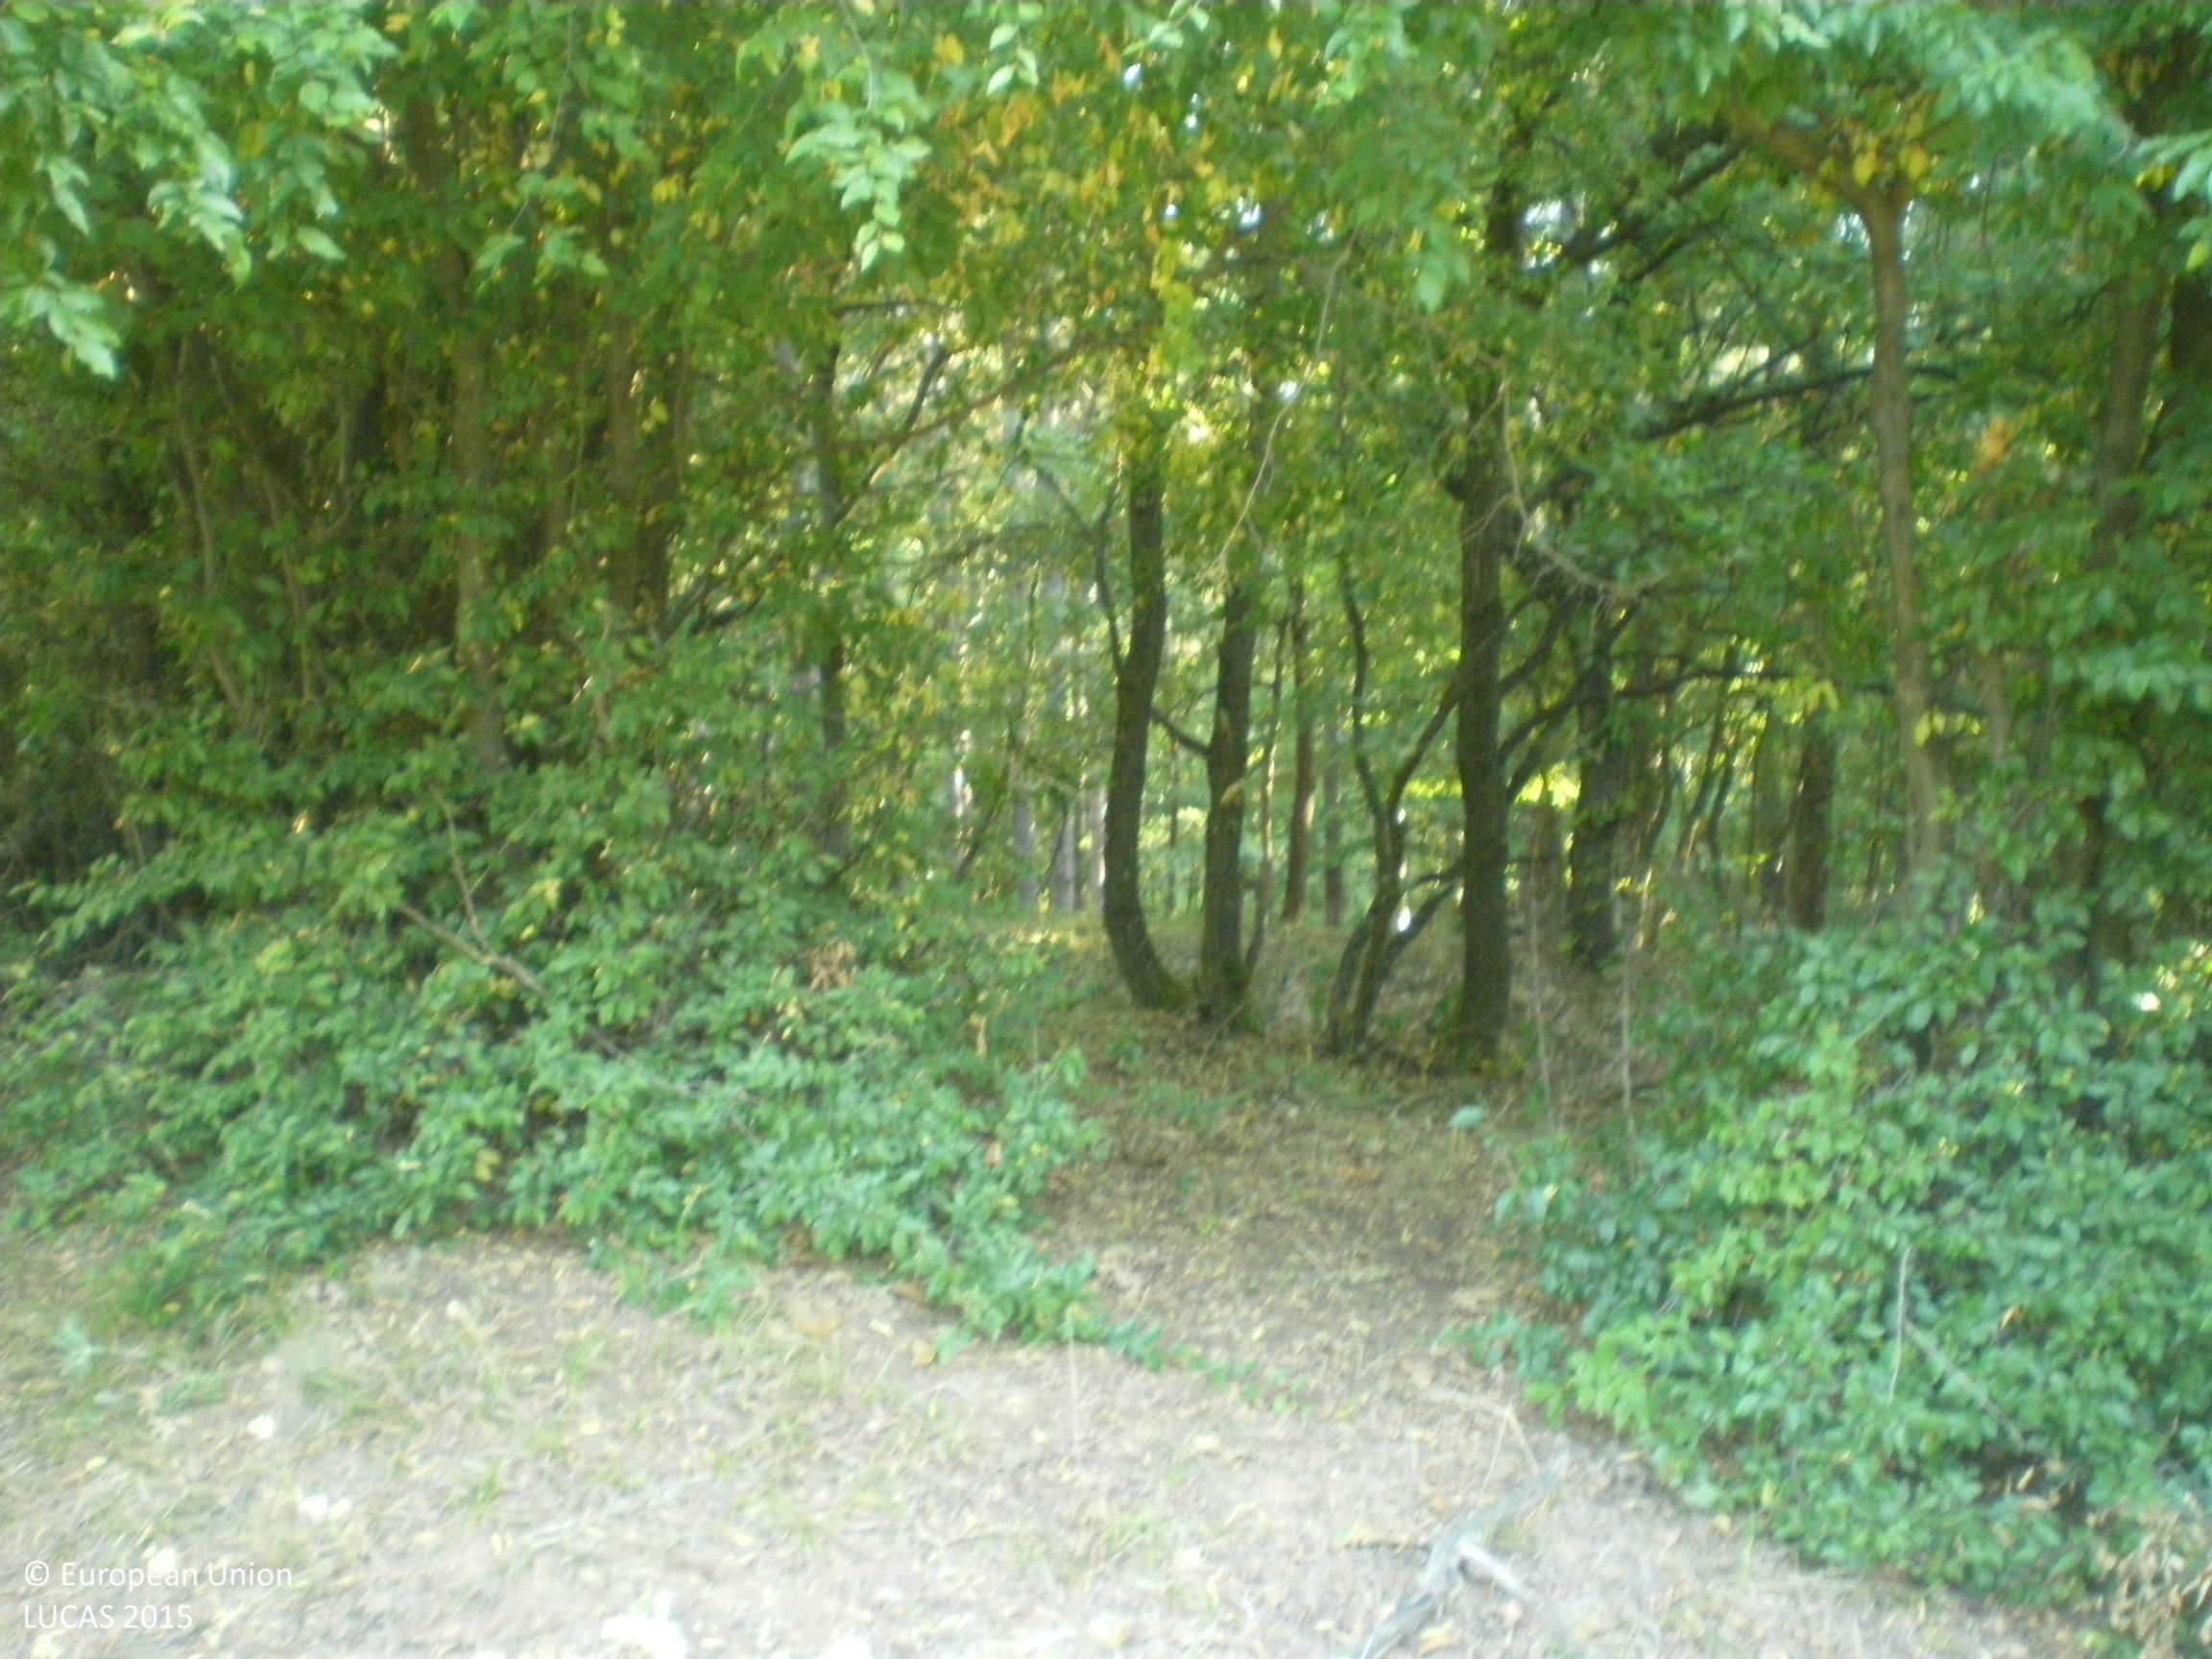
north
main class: Woodland
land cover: Broadleaved woodland
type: mesophytic deciduous forest
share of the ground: > 75 %
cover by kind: broadleaved forest trees 65 %, herbaceous plants 20 %, shrubs 15 %
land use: Forestry
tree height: > 5 m
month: July
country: BG
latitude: 42.6404
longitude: 25.0515
